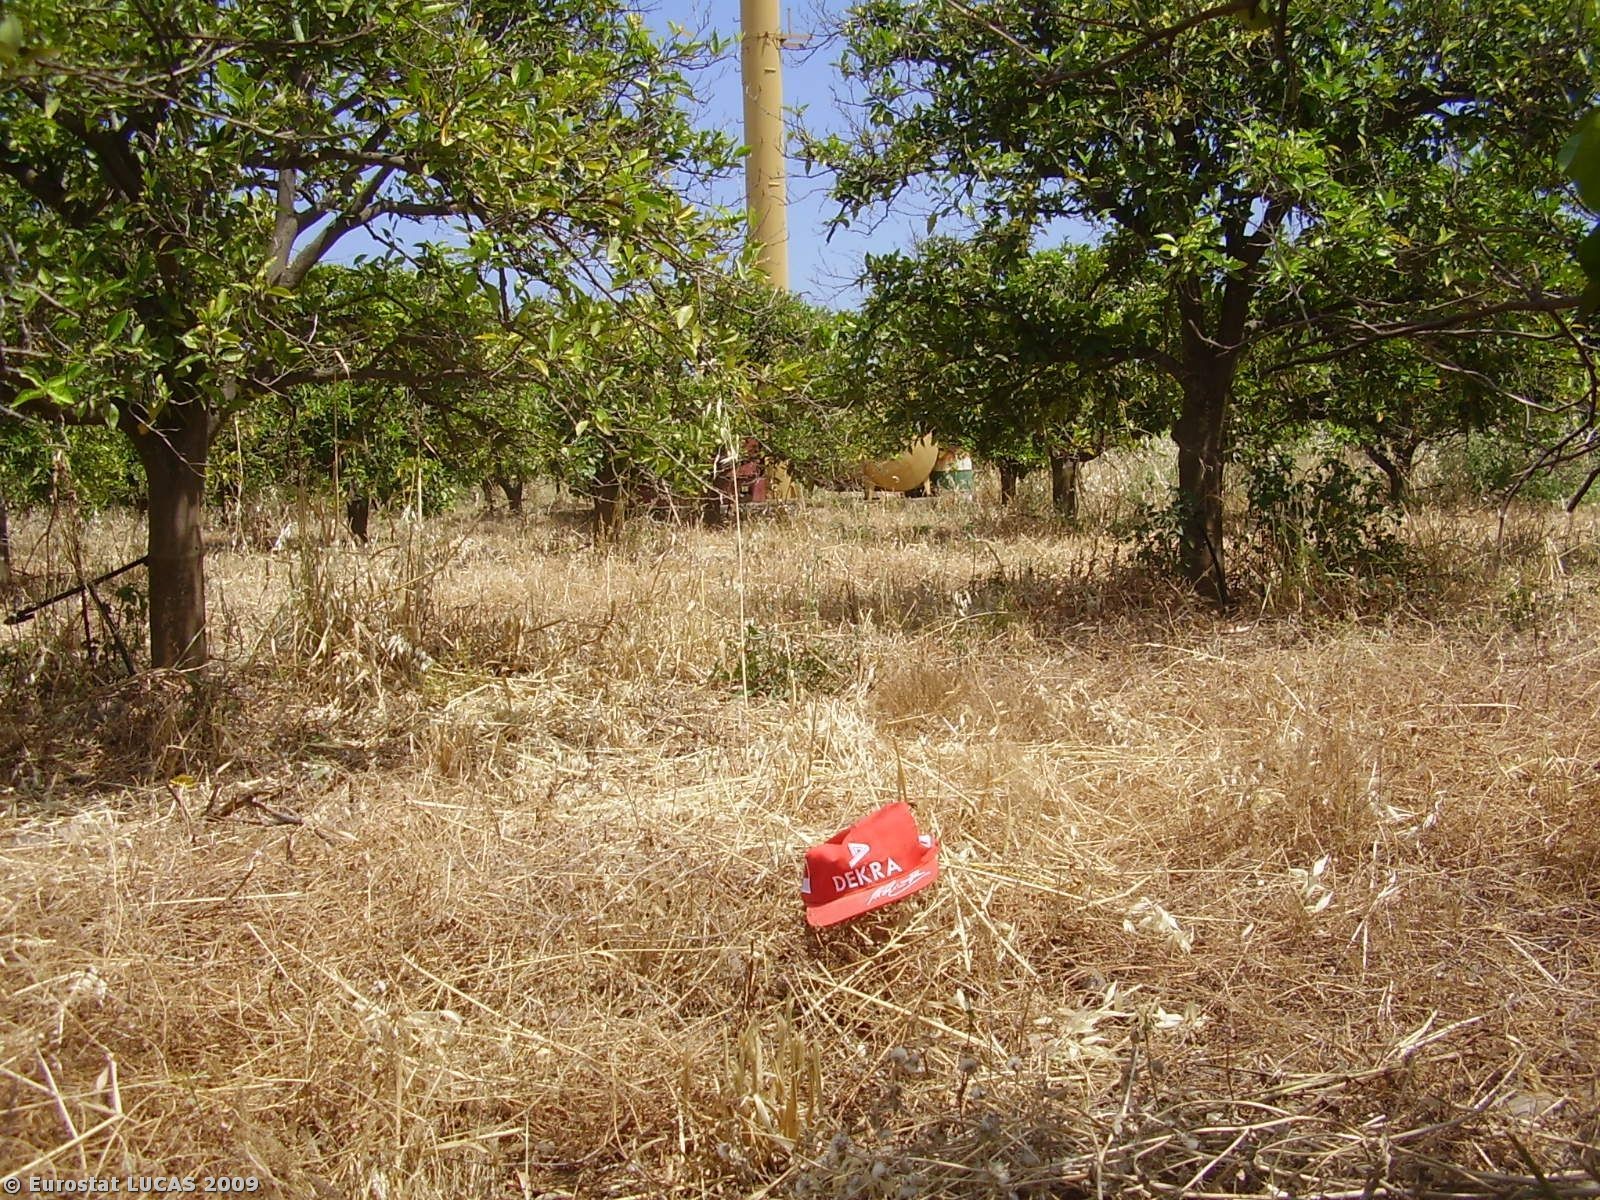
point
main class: Cropland
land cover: Oranges
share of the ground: 25 - 50 %
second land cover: Spontaneously vegetated surfaces
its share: > 75 %
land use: Agriculture (excluding fallow land and kitchen gardens)
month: June
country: IT
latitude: 37.4754
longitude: 14.9059
